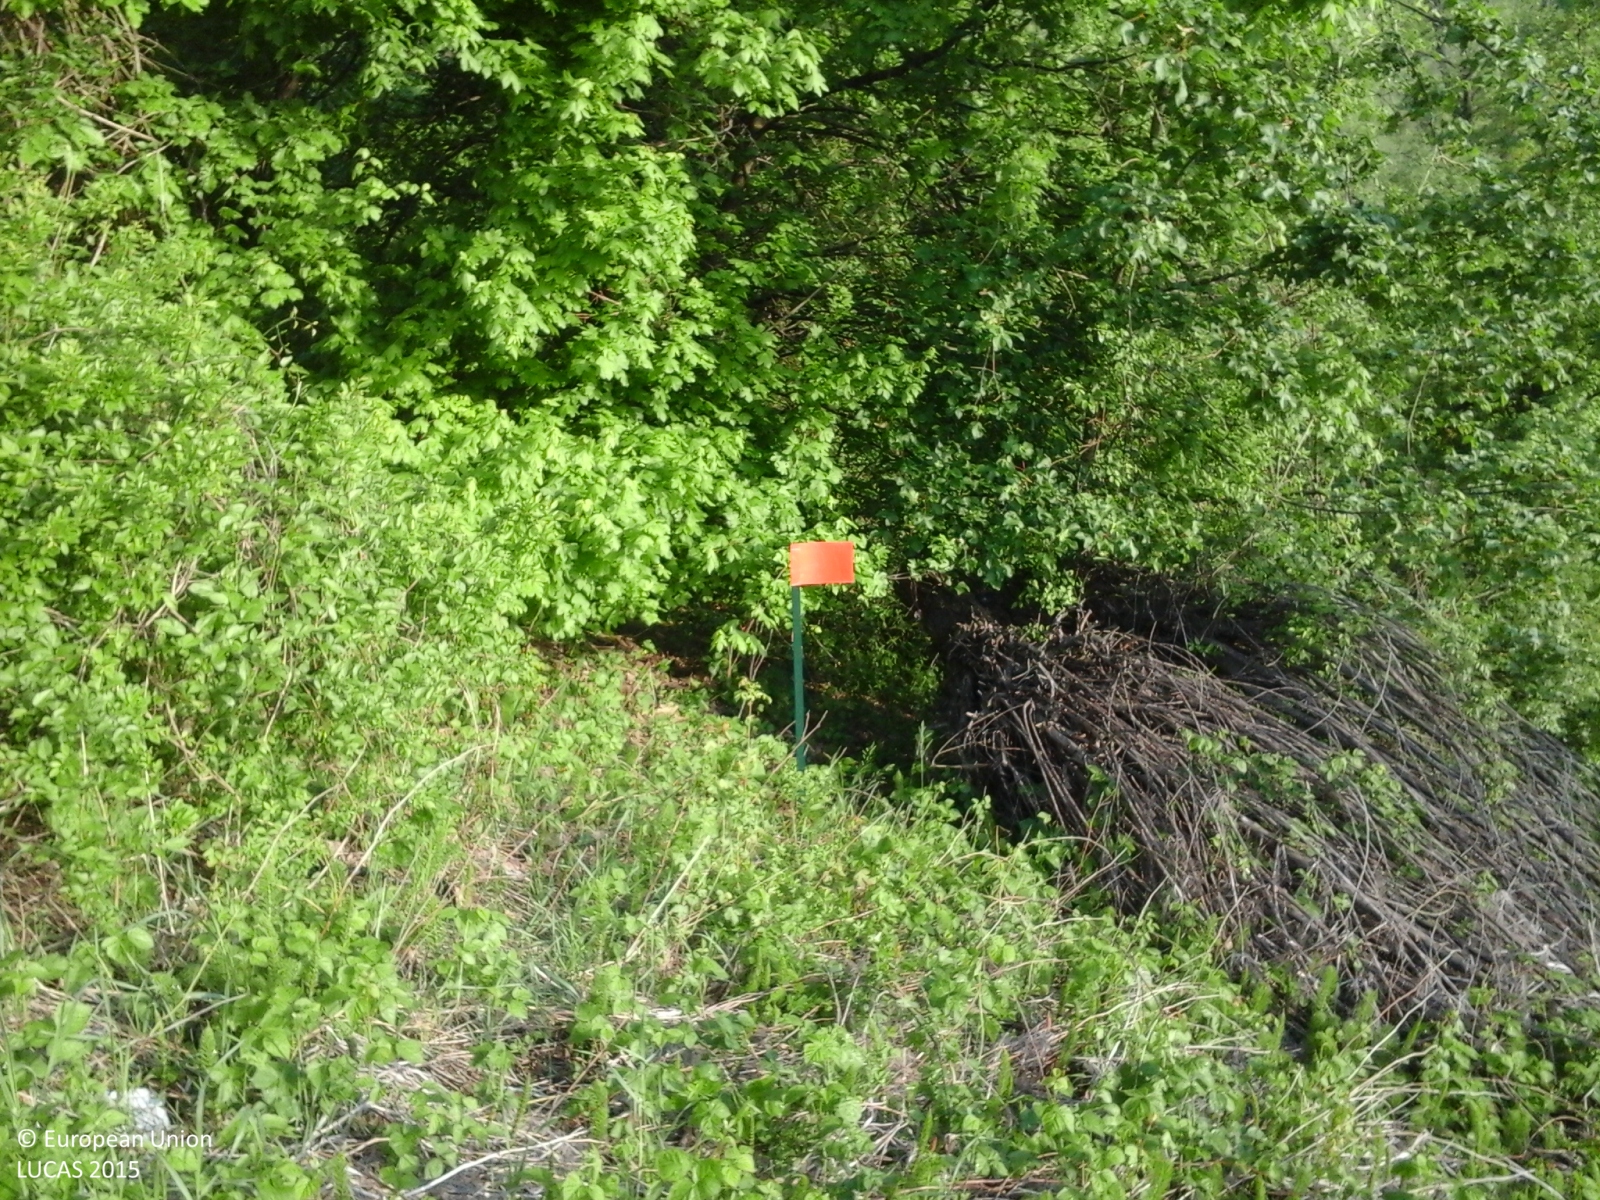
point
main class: Woodland
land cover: Broadleaved woodland
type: mesophytic deciduous forest
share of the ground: > 75 %
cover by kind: broadleaved forest trees 70 %, shrubs 30 %
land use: Semi-natural and natural areas not in use
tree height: > 5 m
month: April
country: IT
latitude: 44.5284
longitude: 10.7157
